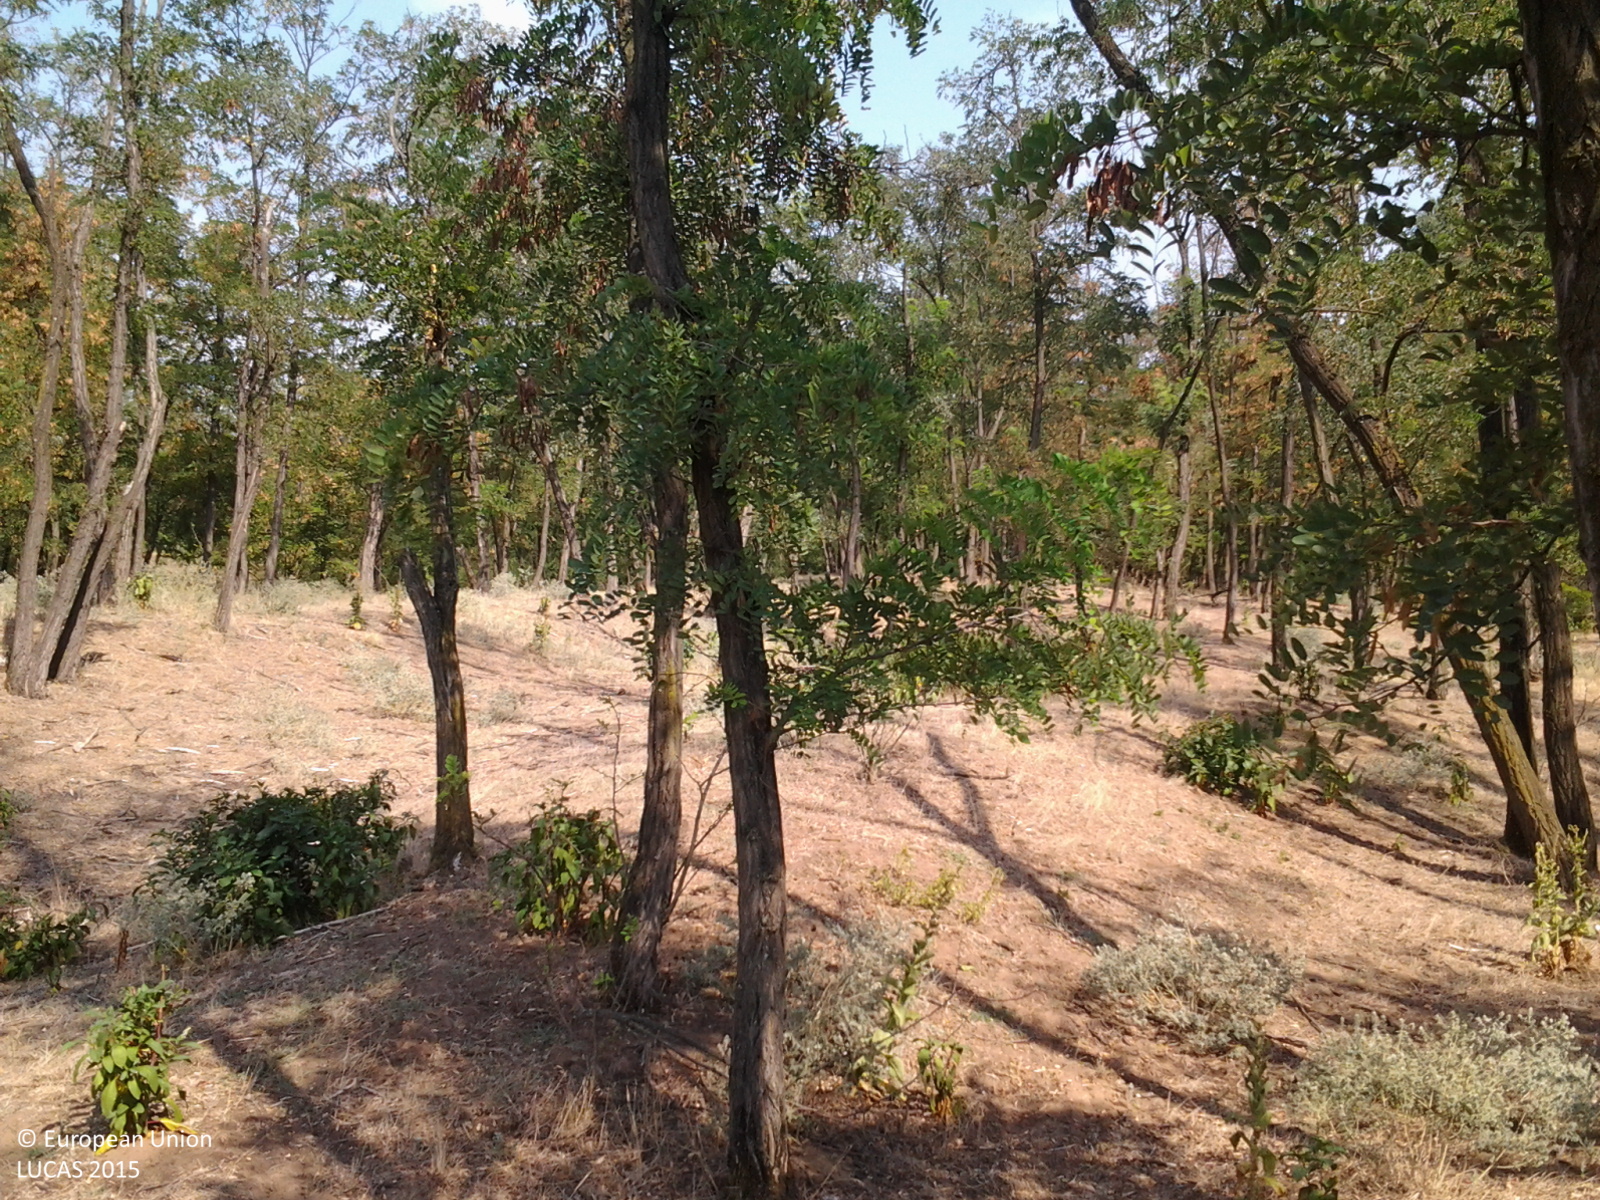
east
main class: Woodland
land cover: Broadleaved woodland
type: exotic forest
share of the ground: > 75 %
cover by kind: broadleaved forest trees 100 %
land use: Forestry
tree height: > 5 m
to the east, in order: Broadleaved woodland; Tracks; Broadleaved woodland
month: August
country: RO
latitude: 43.8668
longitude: 23.0692
